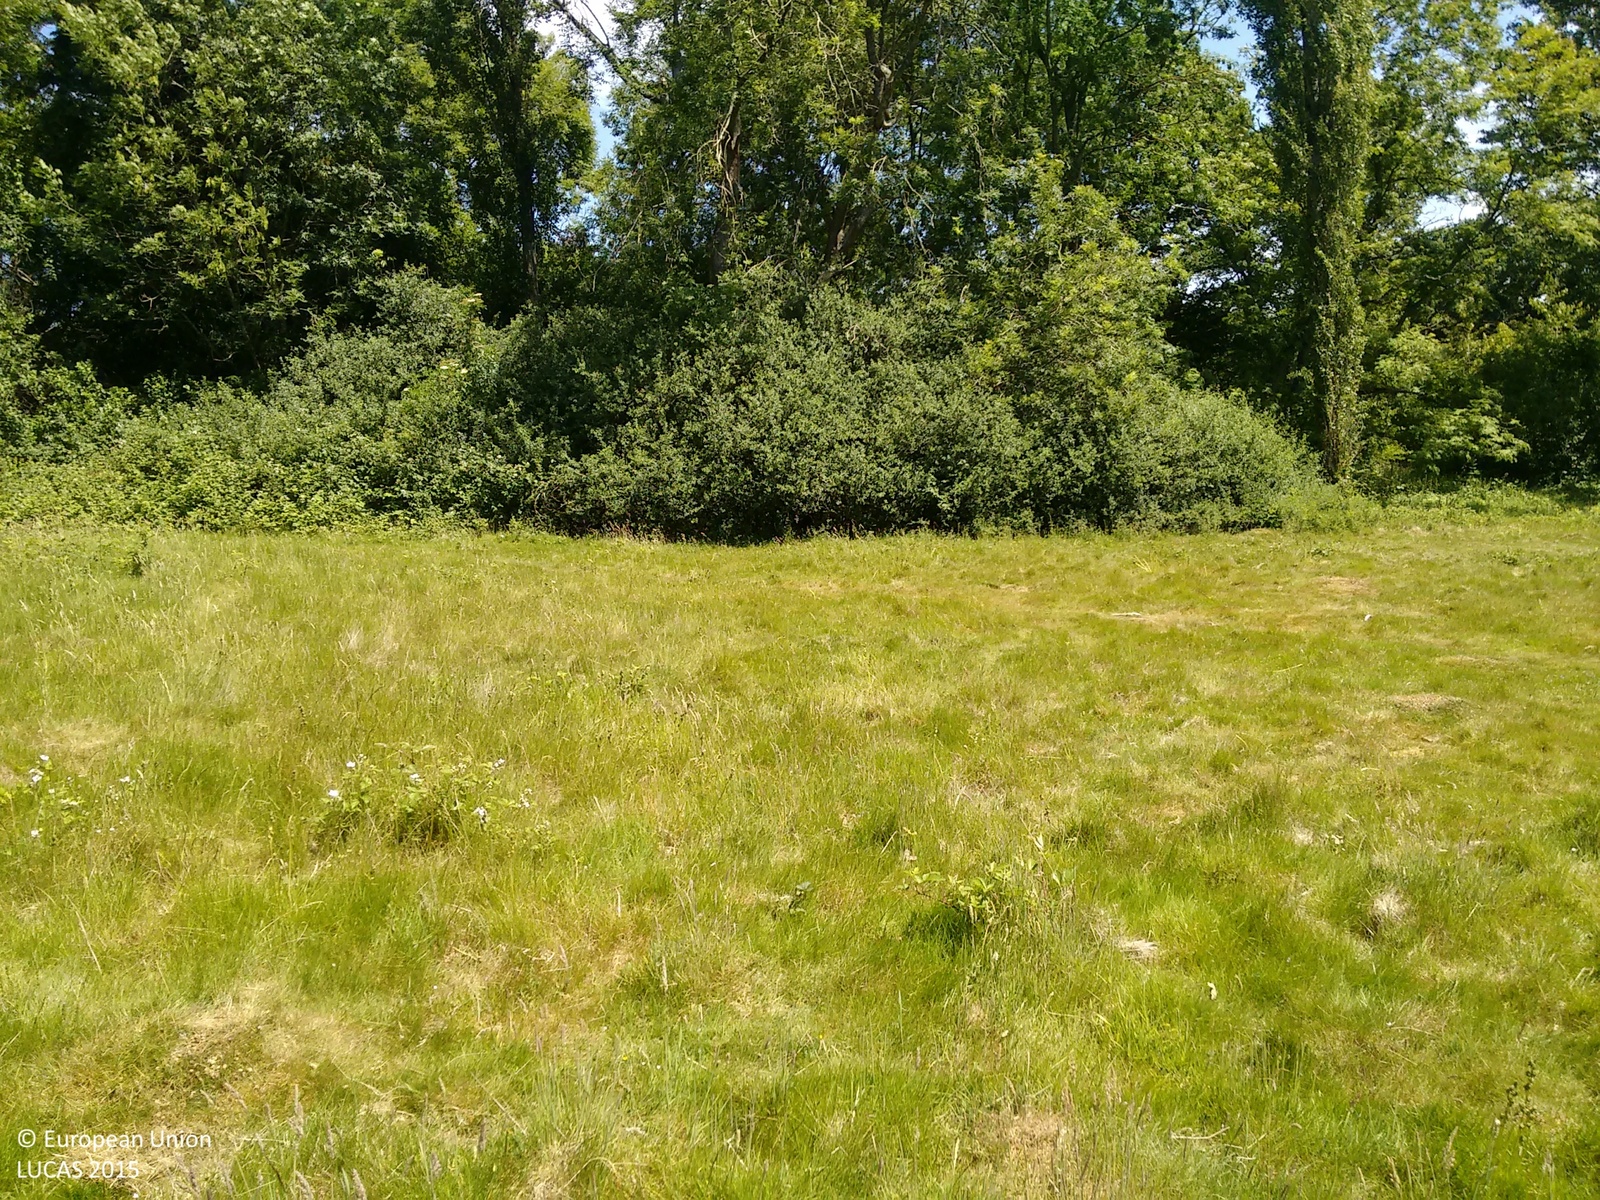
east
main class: Grassland
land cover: Grassland without tree/shrub cover
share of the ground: > 75 %
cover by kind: herbaceous plants 100 %
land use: Semi-natural and natural areas not in use
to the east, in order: Grassland without tree/shrub cover; Electric lines; Grassland without tree/shrub cover; Electric lines; Grassland without tree/shrub cover; Broadleaved woodland; Tracks; Broadleaved woodland; Electric lines; Broadleaved woodland
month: June
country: GB
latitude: 51.2133
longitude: -0.1846
